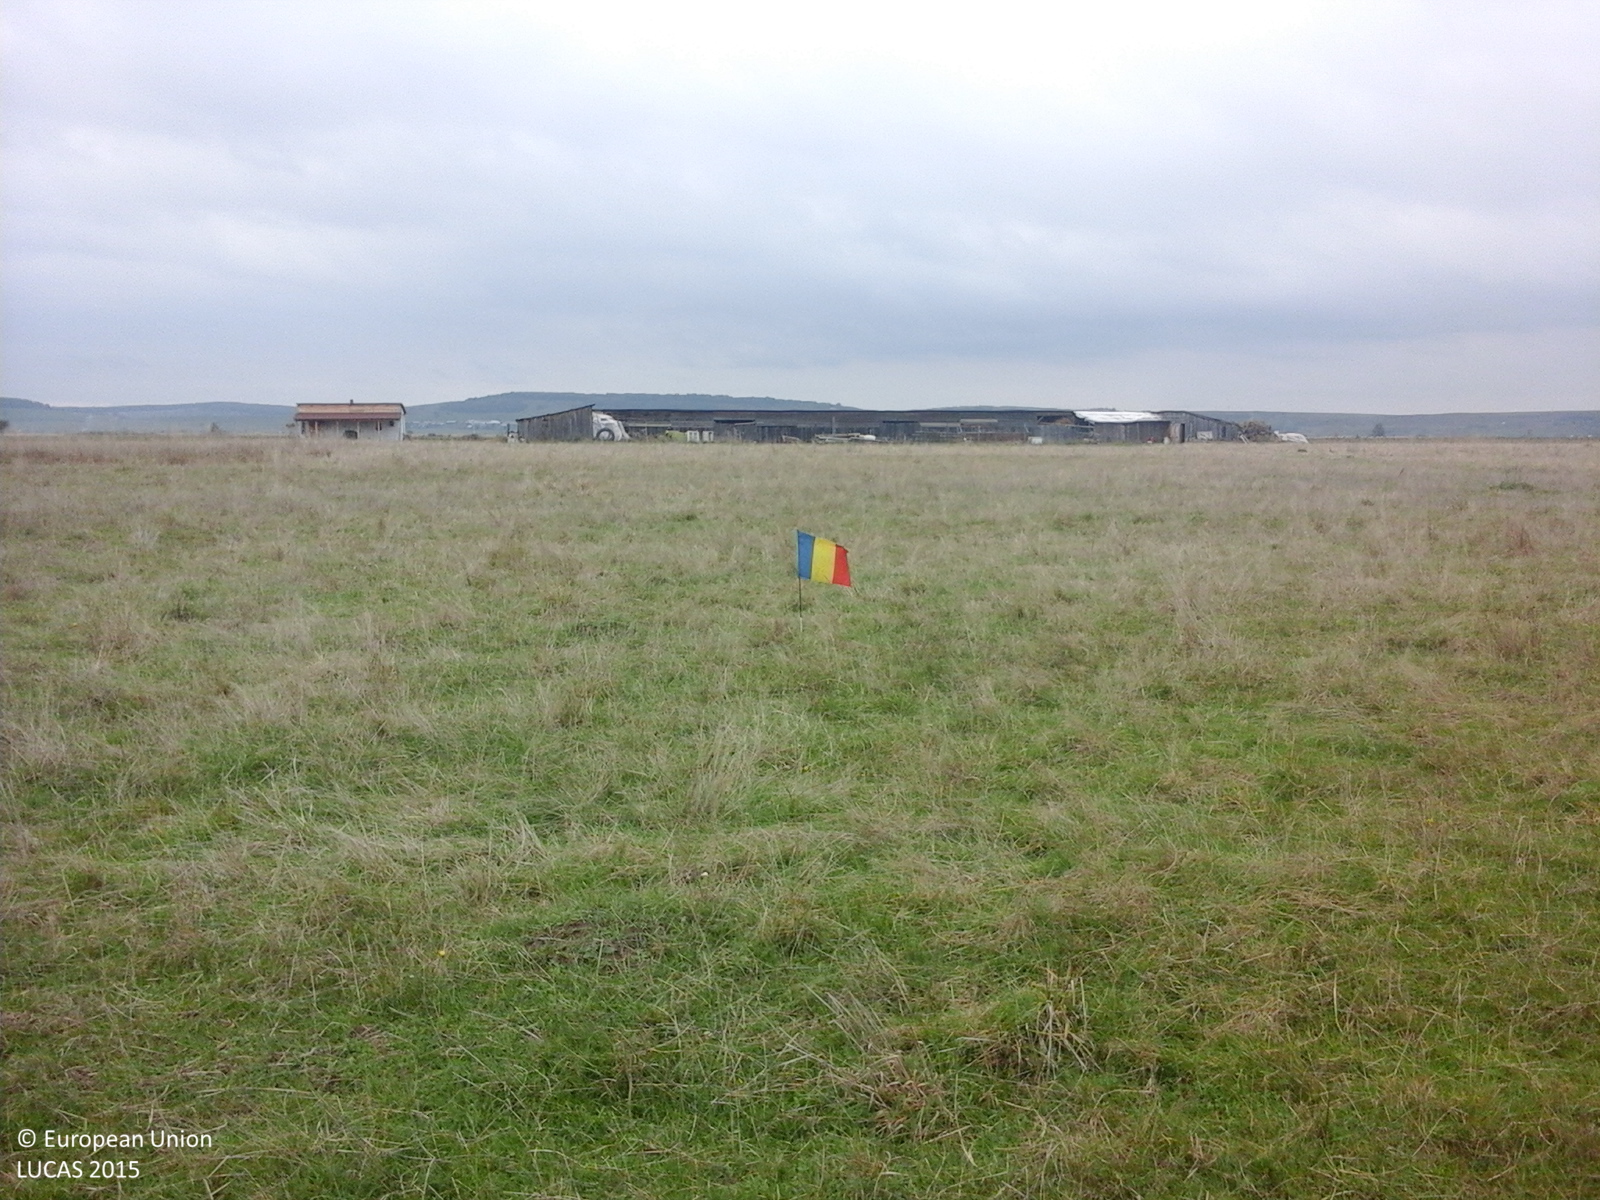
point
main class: Grassland
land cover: Grassland without tree/shrub cover
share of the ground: > 75 %
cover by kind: herbaceous plants 100 %
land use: Agriculture (excluding fallow land and kitchen gardens)
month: October
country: RO
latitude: 45.7655
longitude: 24.0496
